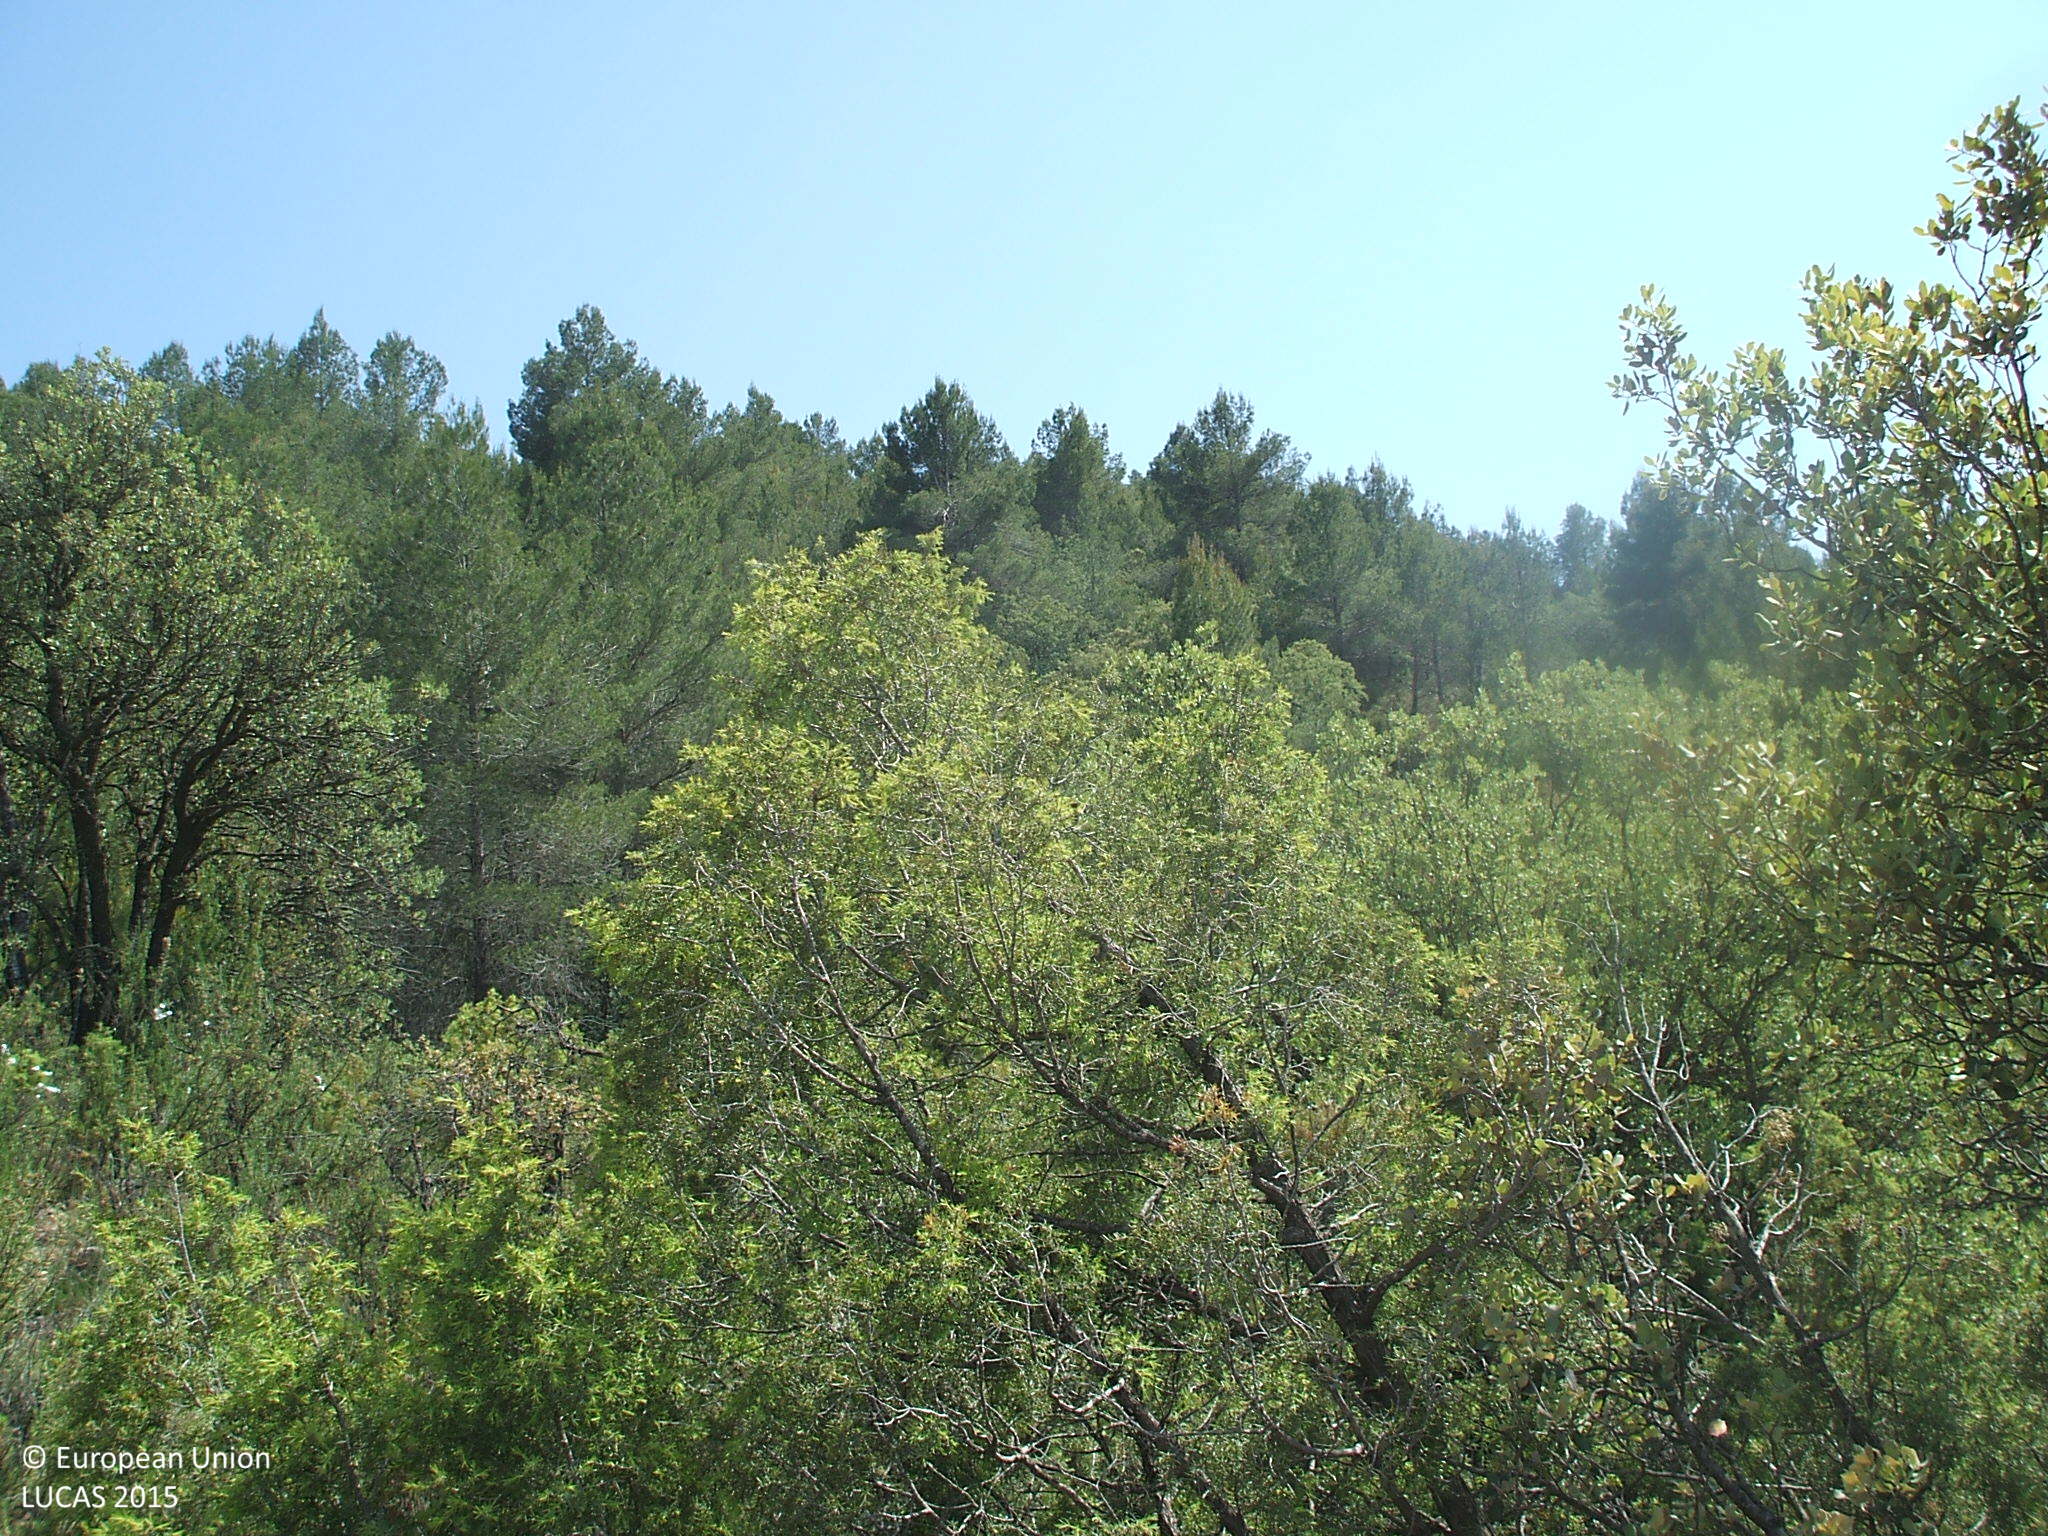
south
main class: Woodland
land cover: Pine dominated mixed woodland
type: coniferous forest of the mediterranean region
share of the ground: 25 - 50 %
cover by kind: consolidated bare surface 50 %, shrubs 20 %, coniferous forest trees 15 %, broadleaved forest trees 15 %
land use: Semi-natural and natural areas not in use
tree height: > 5 m
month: May
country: ES
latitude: 40.7408
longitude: -0.1575
